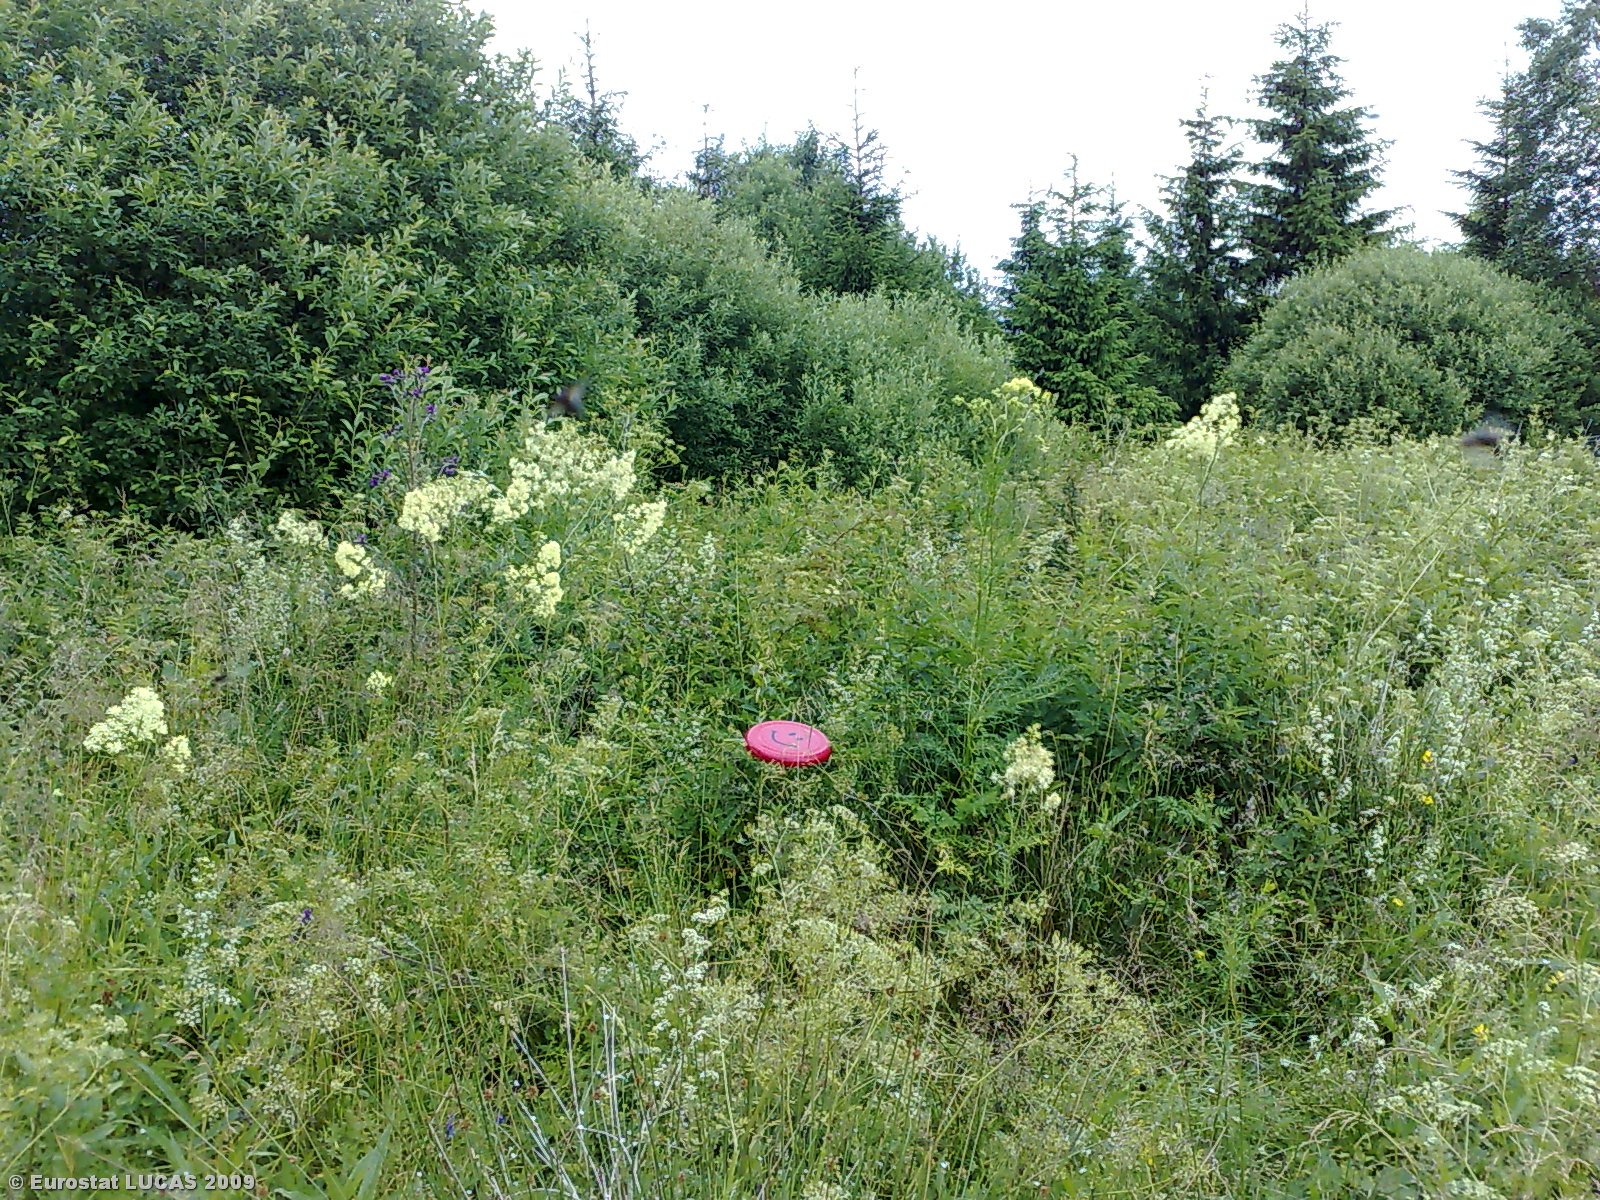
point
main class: Grassland
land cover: Grassland with sparse tree/shrub cover
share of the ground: > 75 %
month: July
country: LT
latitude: 55.5939
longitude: 22.8407
